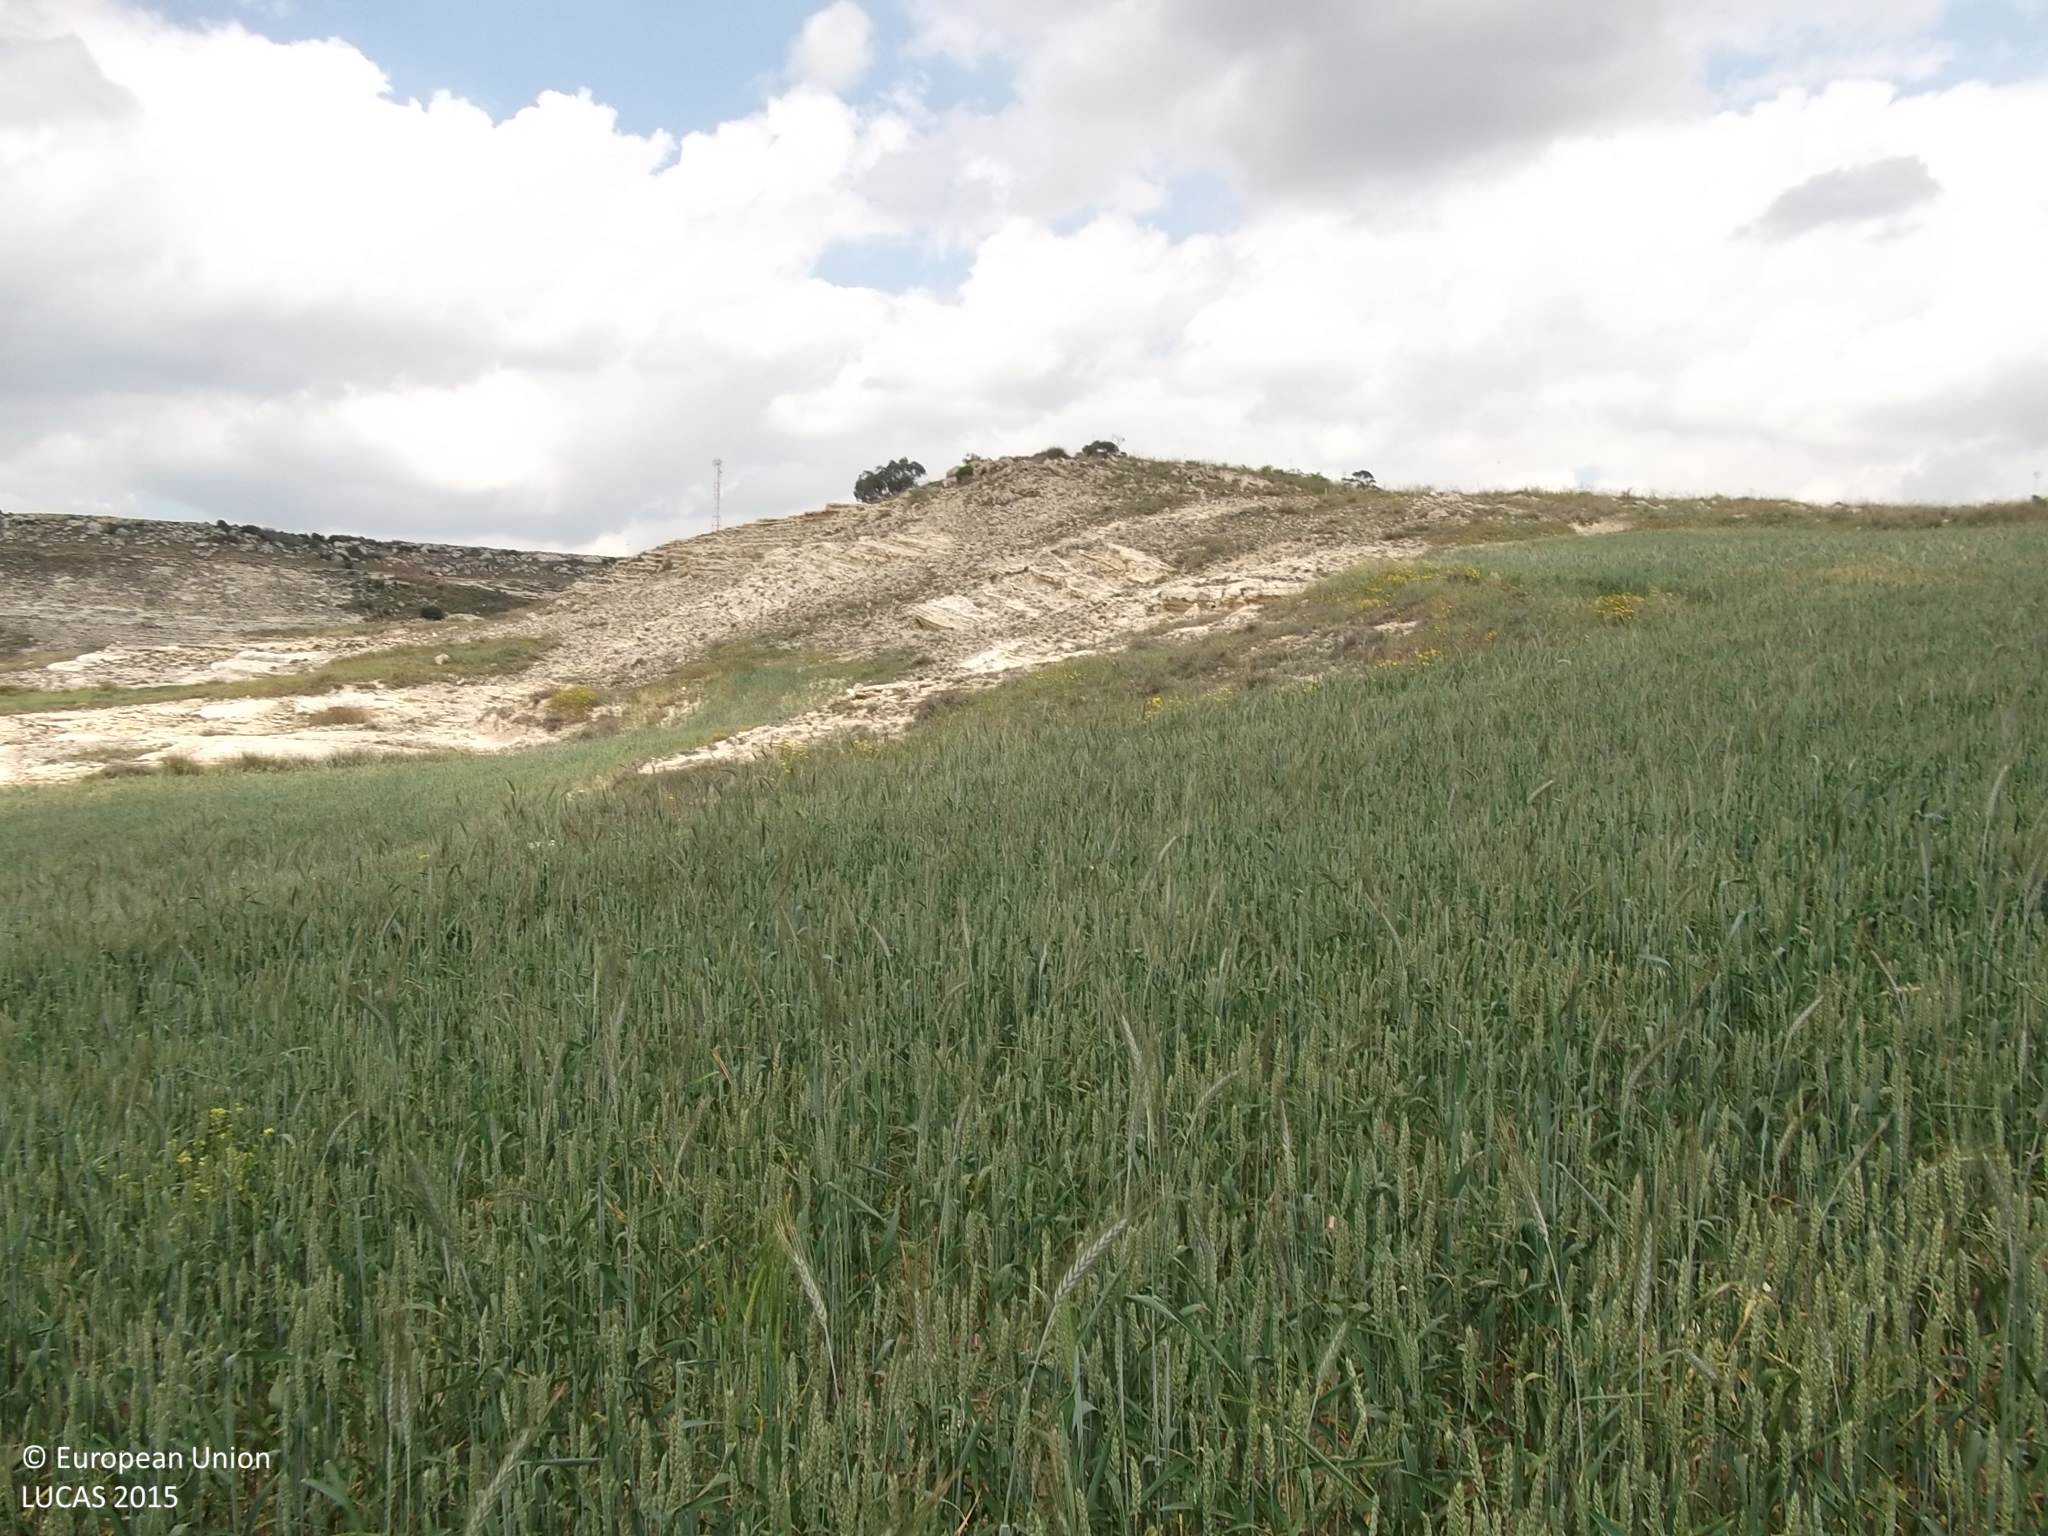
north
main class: Cropland
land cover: Common wheat
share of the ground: > 75 %
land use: Agriculture (excluding fallow land and kitchen gardens)
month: April
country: CY
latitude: 35.0103
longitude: 33.6853
